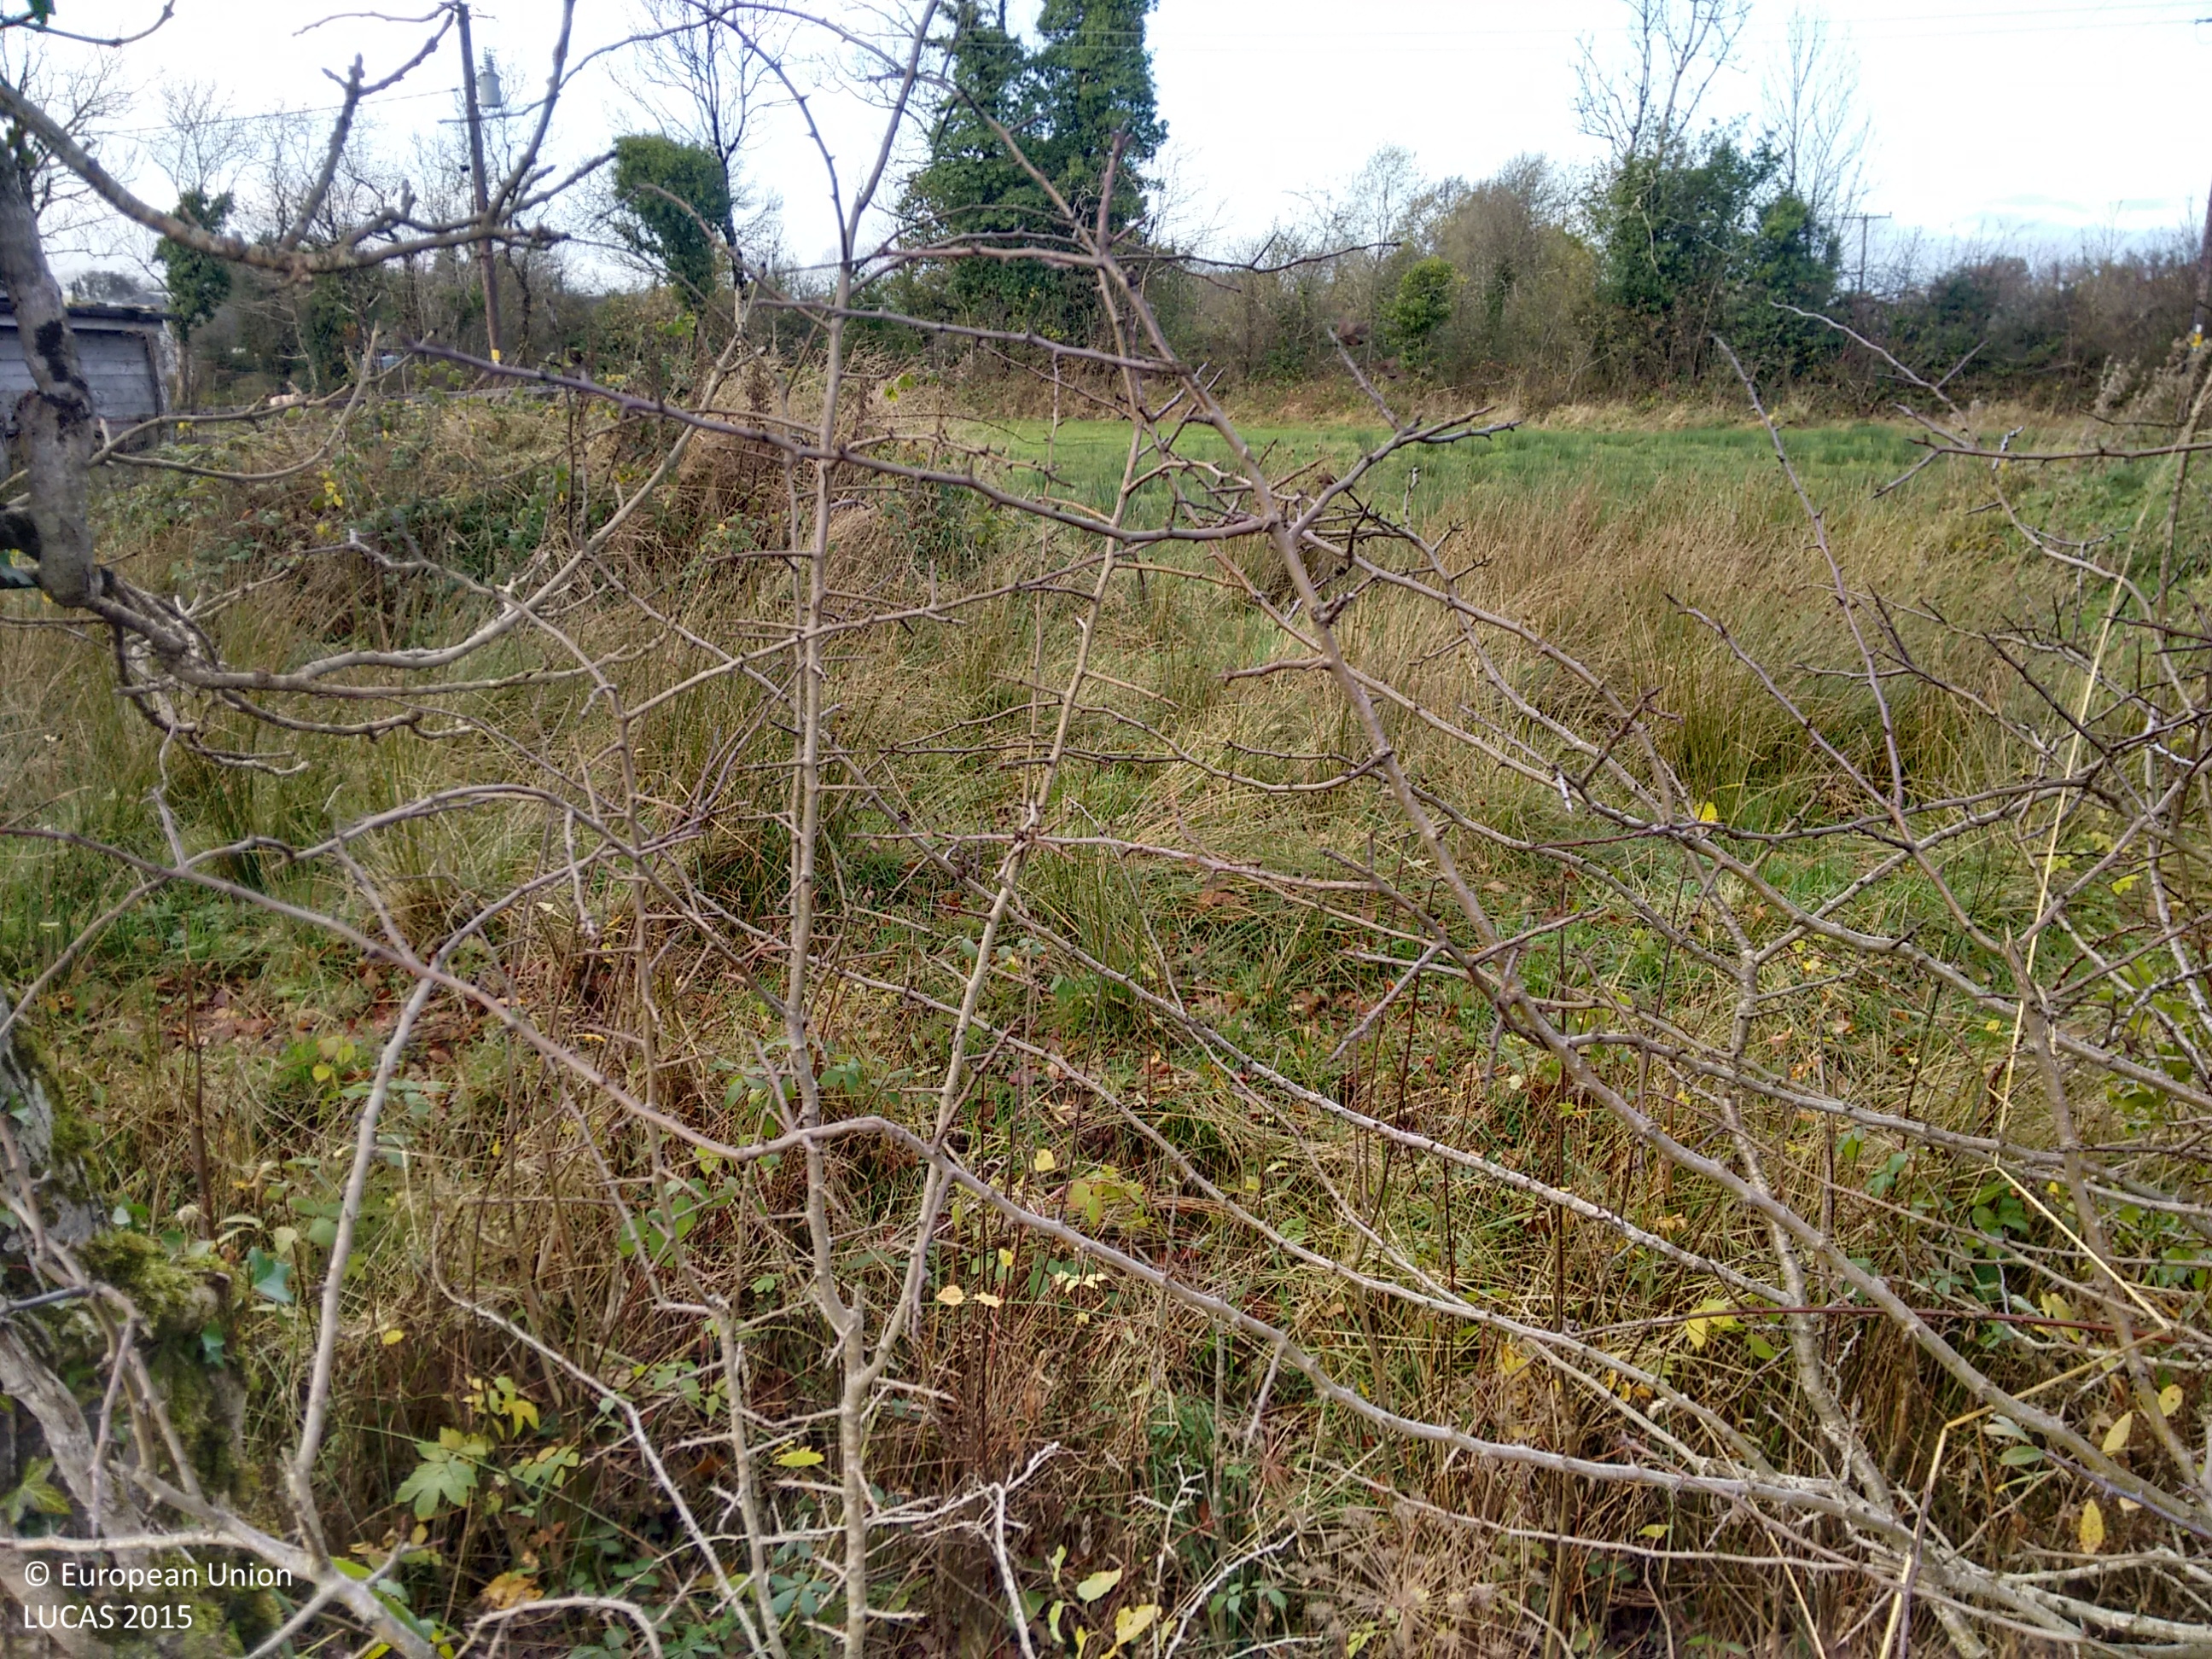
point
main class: Grassland
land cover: Grassland without tree/shrub cover
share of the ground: > 75 %
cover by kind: herbaceous plants 100 %
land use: Agriculture (excluding fallow land and kitchen gardens)
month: November
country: IE
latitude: 53.7541
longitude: -7.7436
